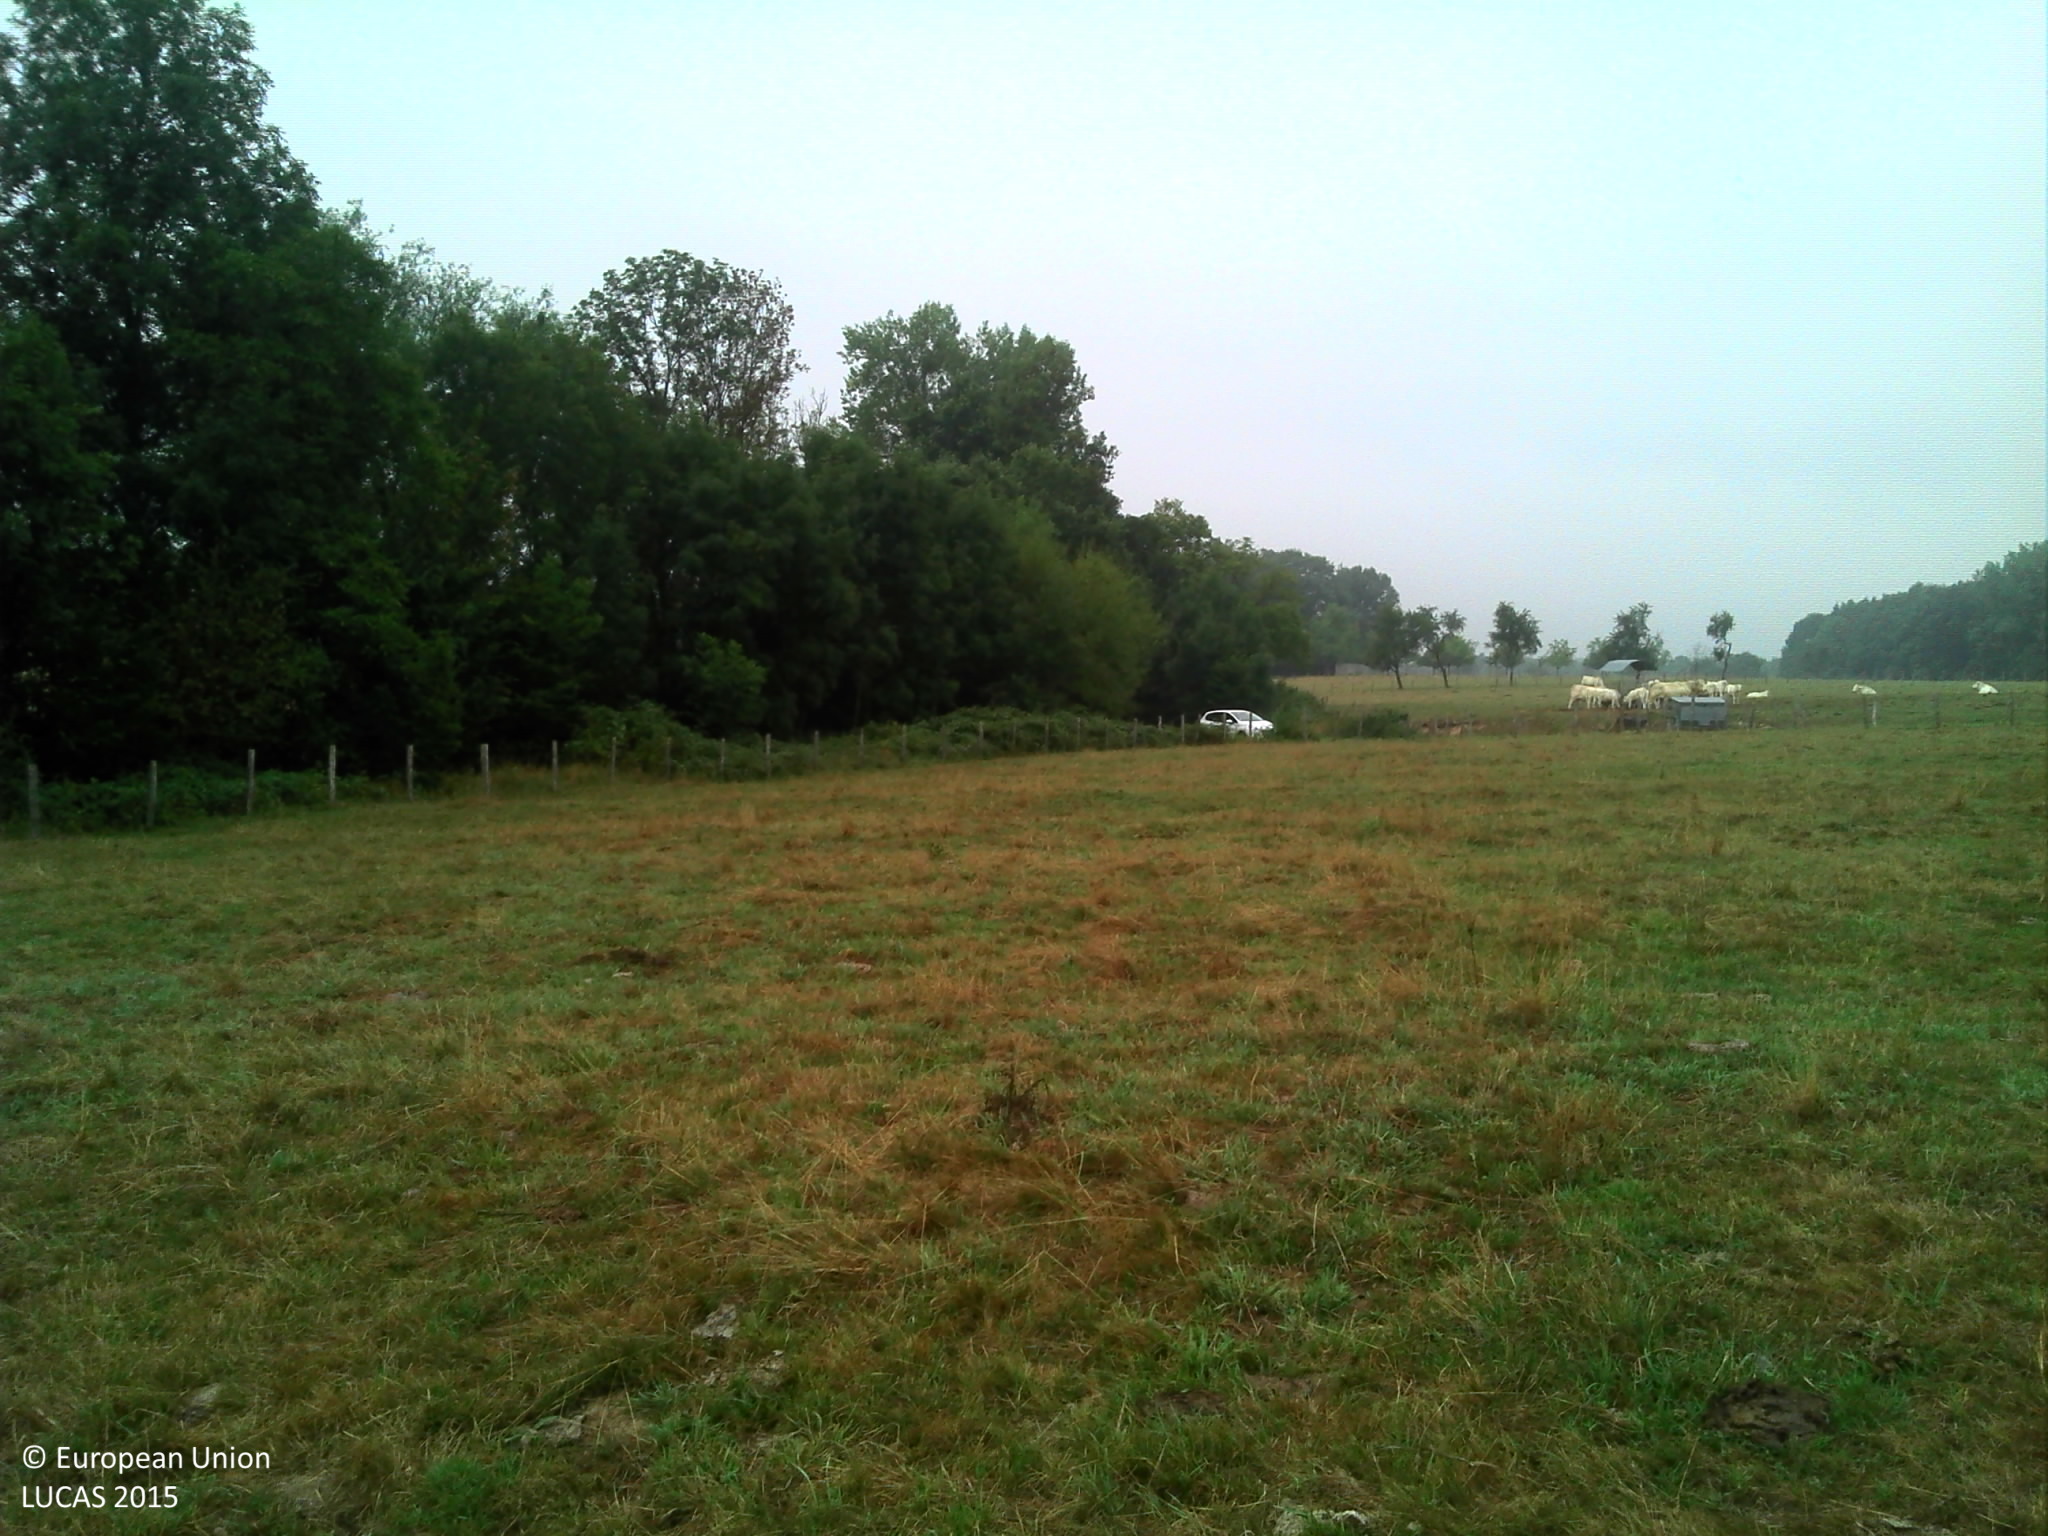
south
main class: Grassland
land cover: Grassland without tree/shrub cover
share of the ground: > 75 %
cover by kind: herbaceous plants 100 %
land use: Agriculture (excluding fallow land and kitchen gardens)
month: August
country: FR
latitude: 48.8377
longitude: 7.2621
